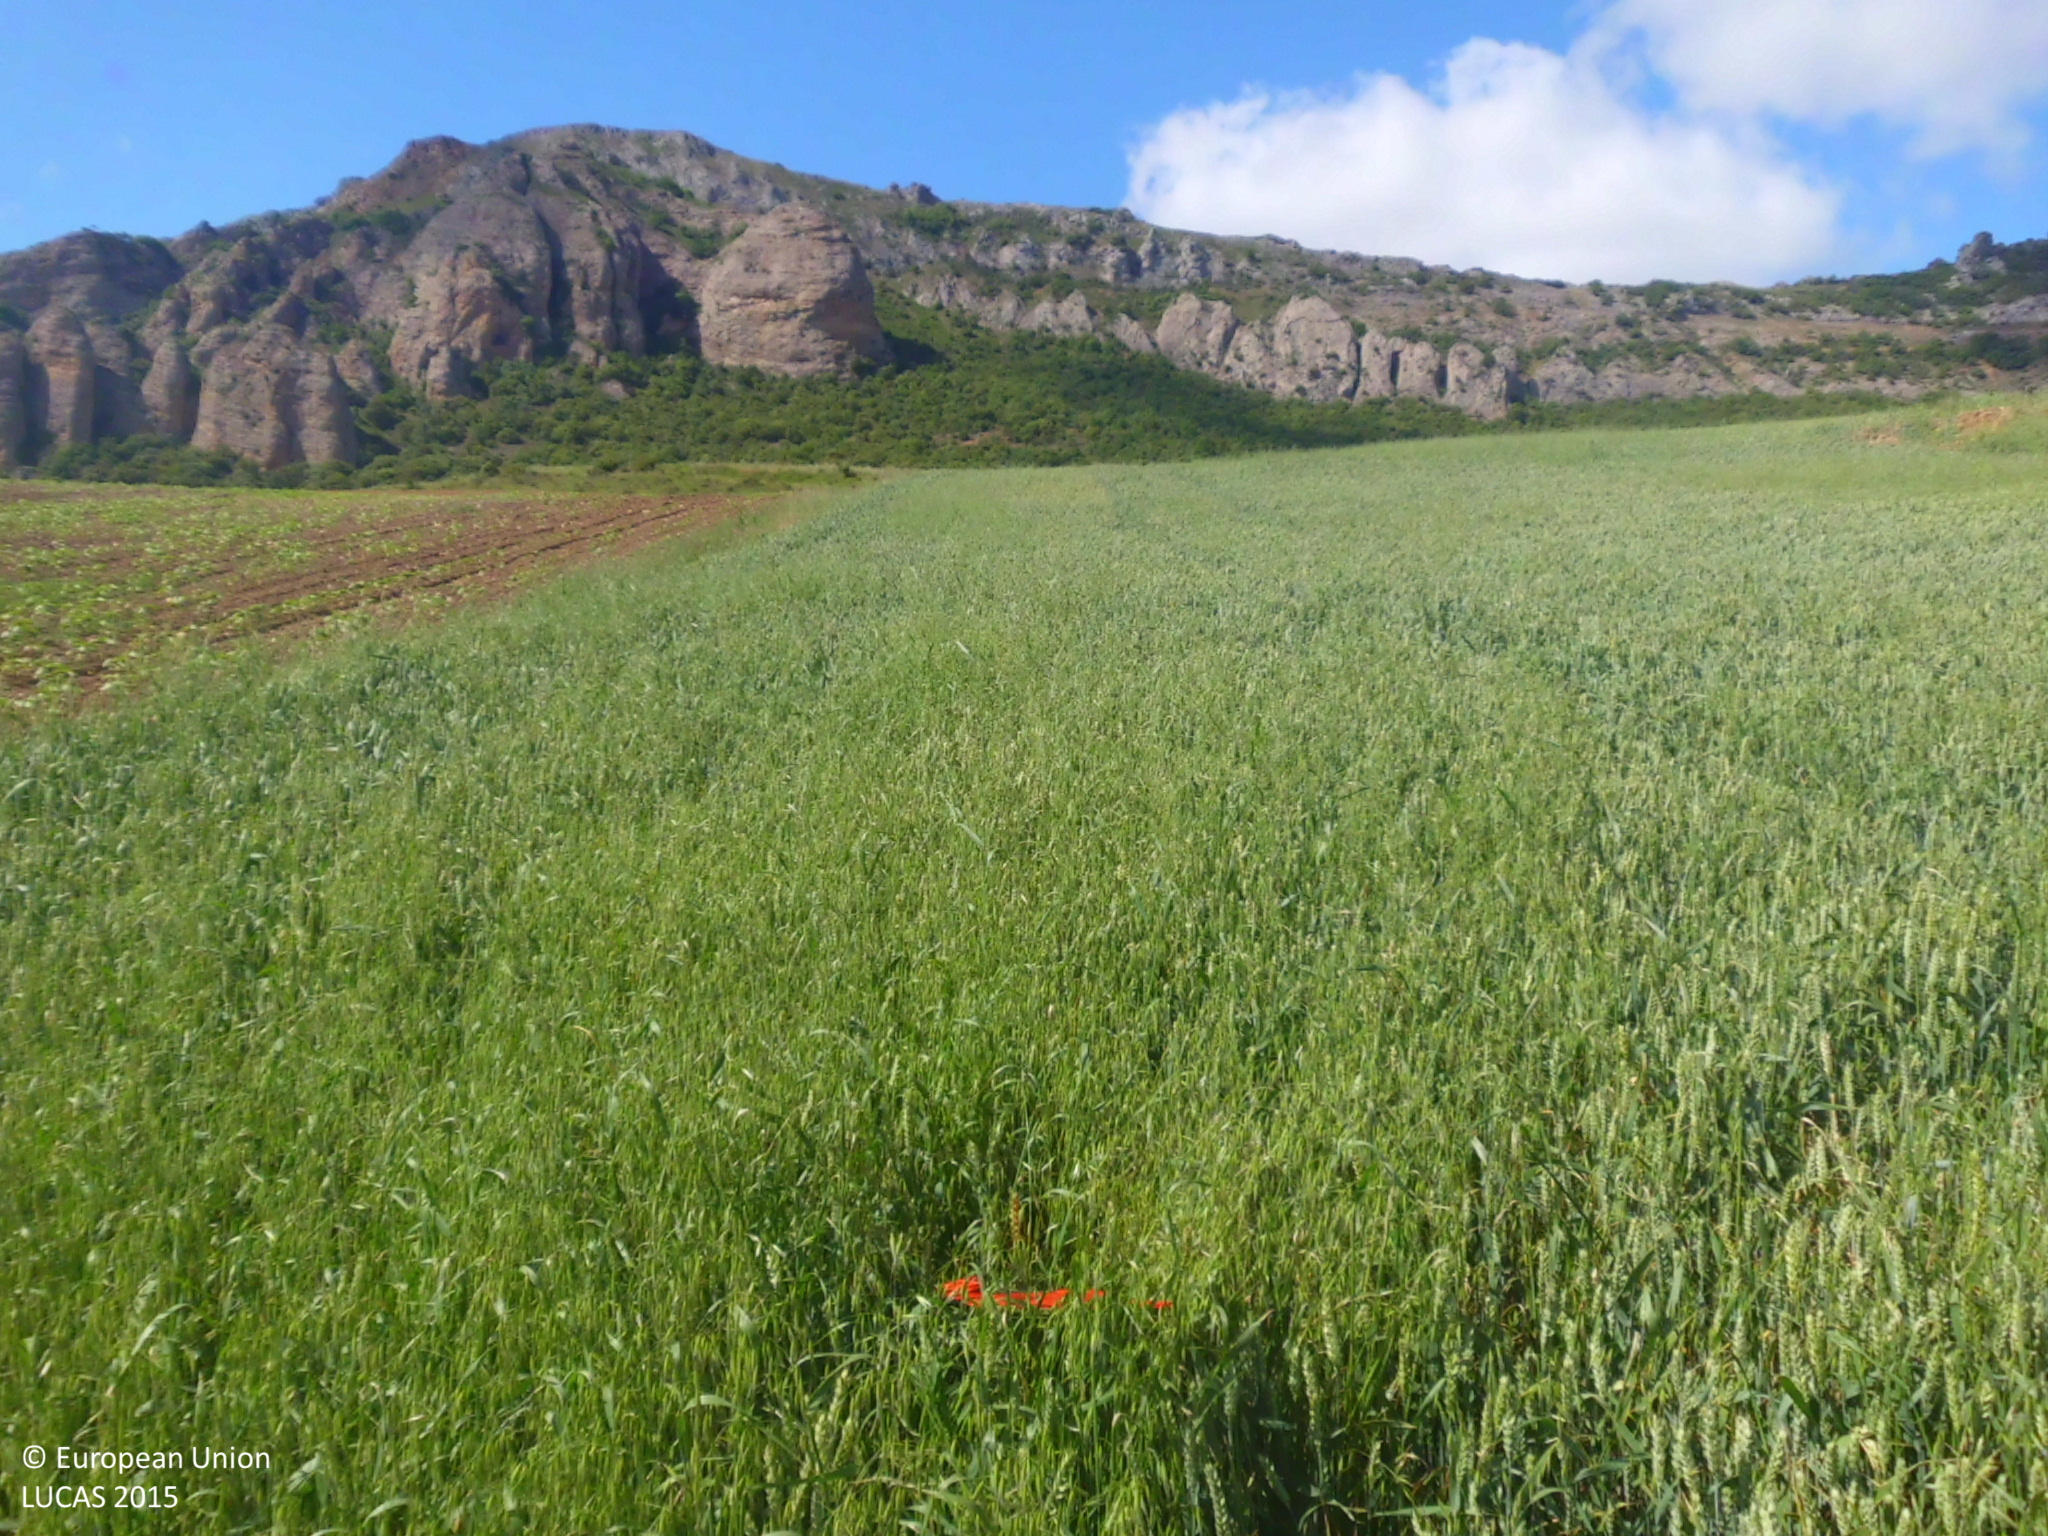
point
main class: Cropland
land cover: Common wheat
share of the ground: > 75 %
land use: Agriculture (excluding fallow land and kitchen gardens)
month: June
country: ES
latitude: 42.6863
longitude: -3.3005
